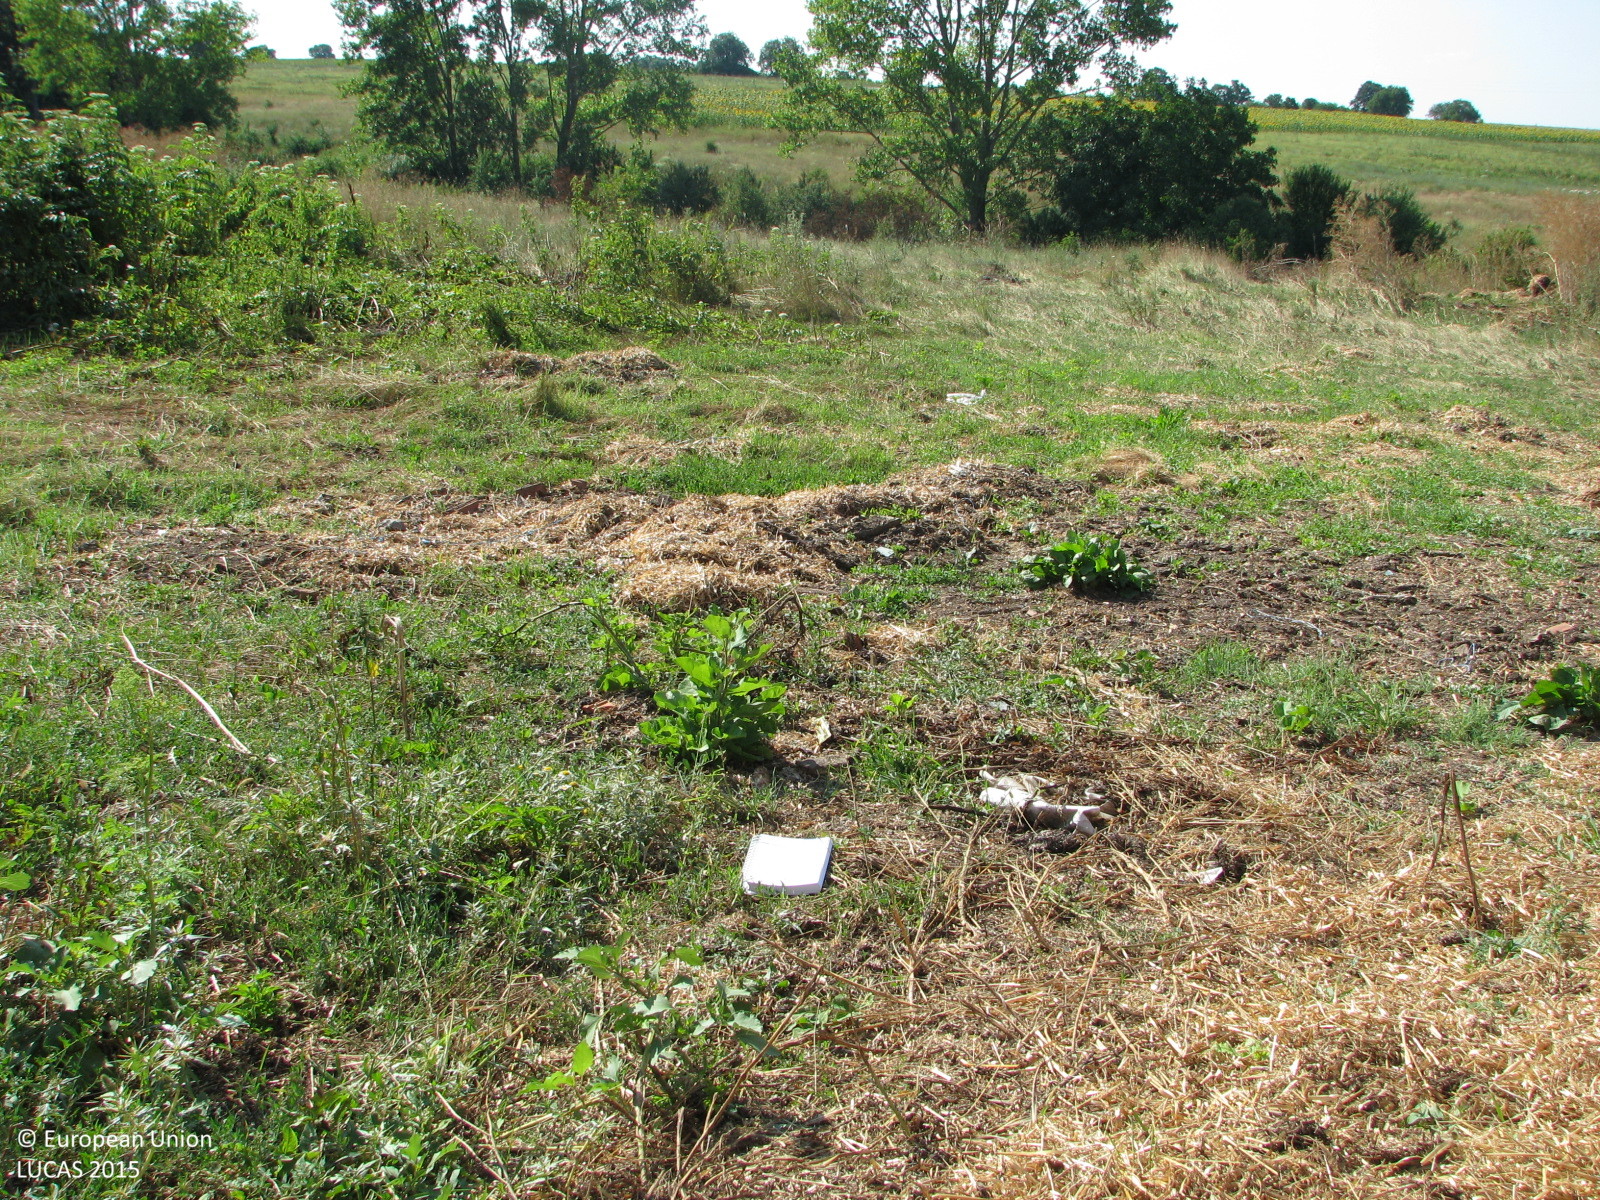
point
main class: Grassland
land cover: Spontaneously vegetated surfaces
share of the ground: > 75 %
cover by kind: herbaceous plants 100 %
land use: Agriculture (excluding fallow land and kitchen gardens)
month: July
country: BG
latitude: 42.2686
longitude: 26.9152
